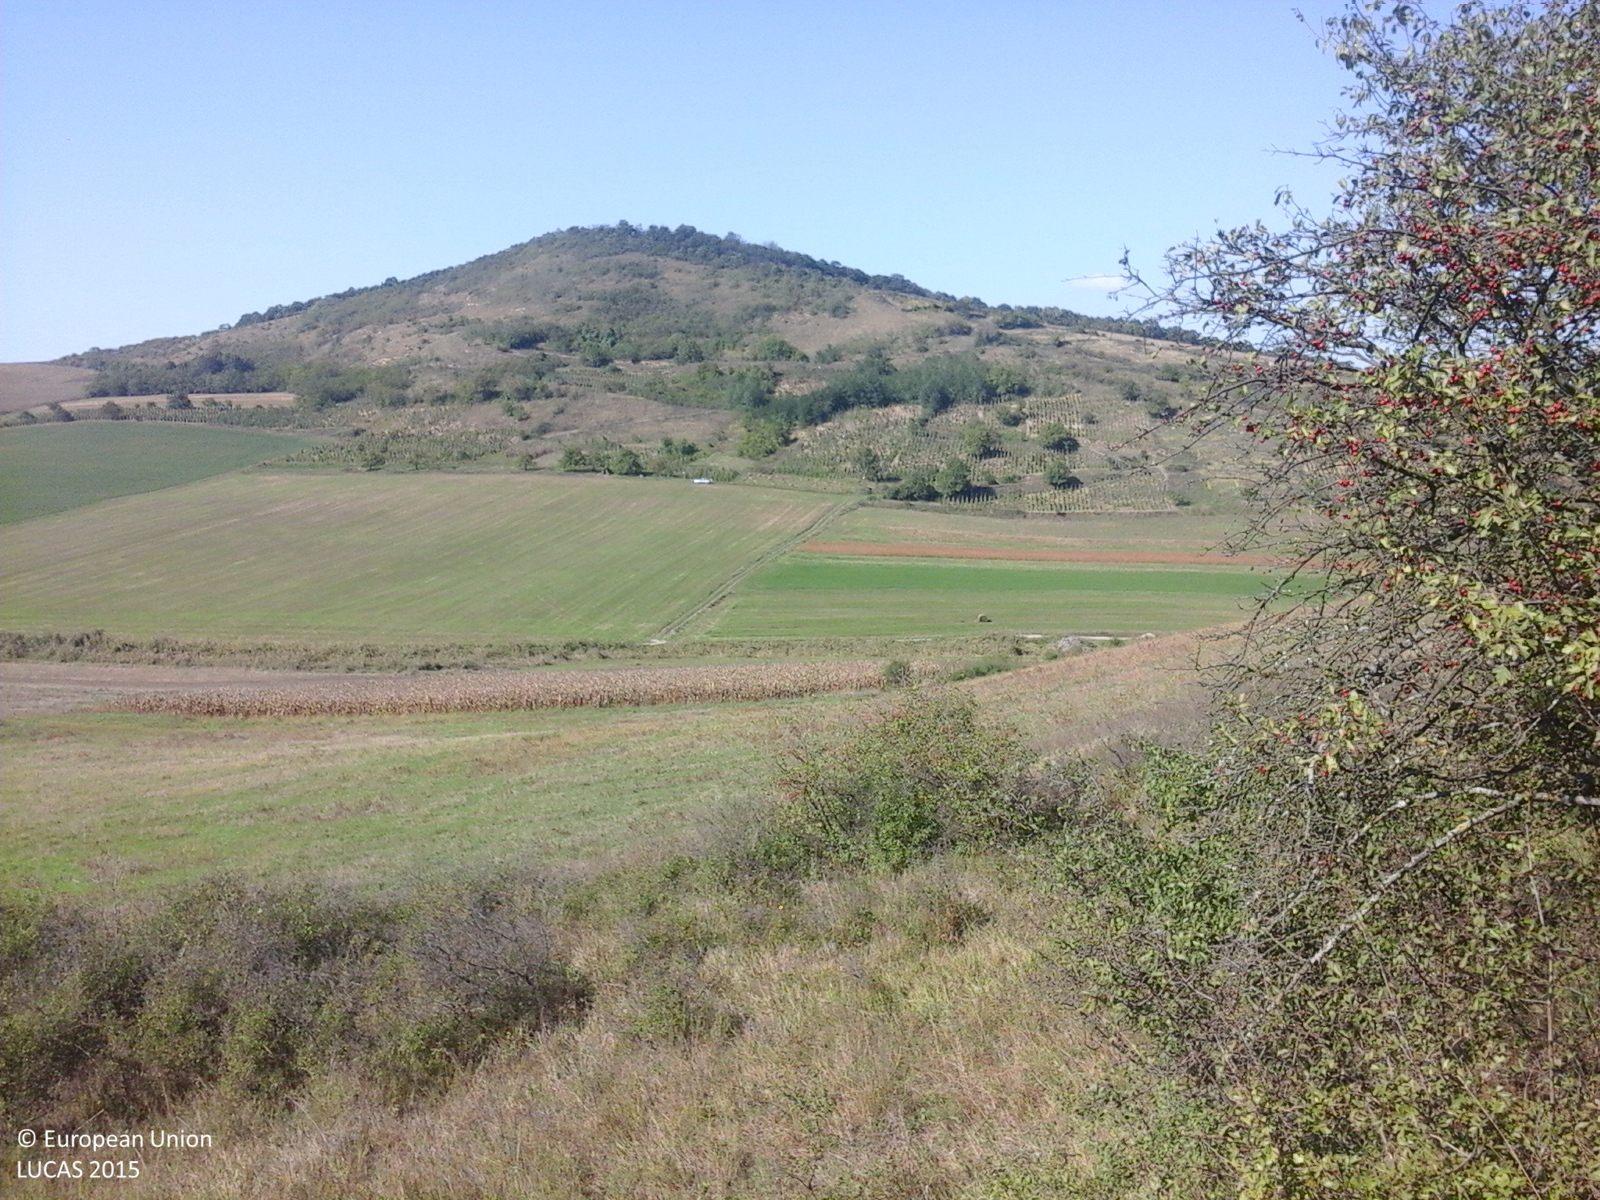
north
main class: Grassland
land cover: Grassland with sparse tree/shrub cover
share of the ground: > 75 %
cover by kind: herbaceous plants 85 %, shrubs 10 %, broadleaved forest trees 5 %
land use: Fallow land
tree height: < 5 m
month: October
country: RO
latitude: 46.2715
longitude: 23.8135
